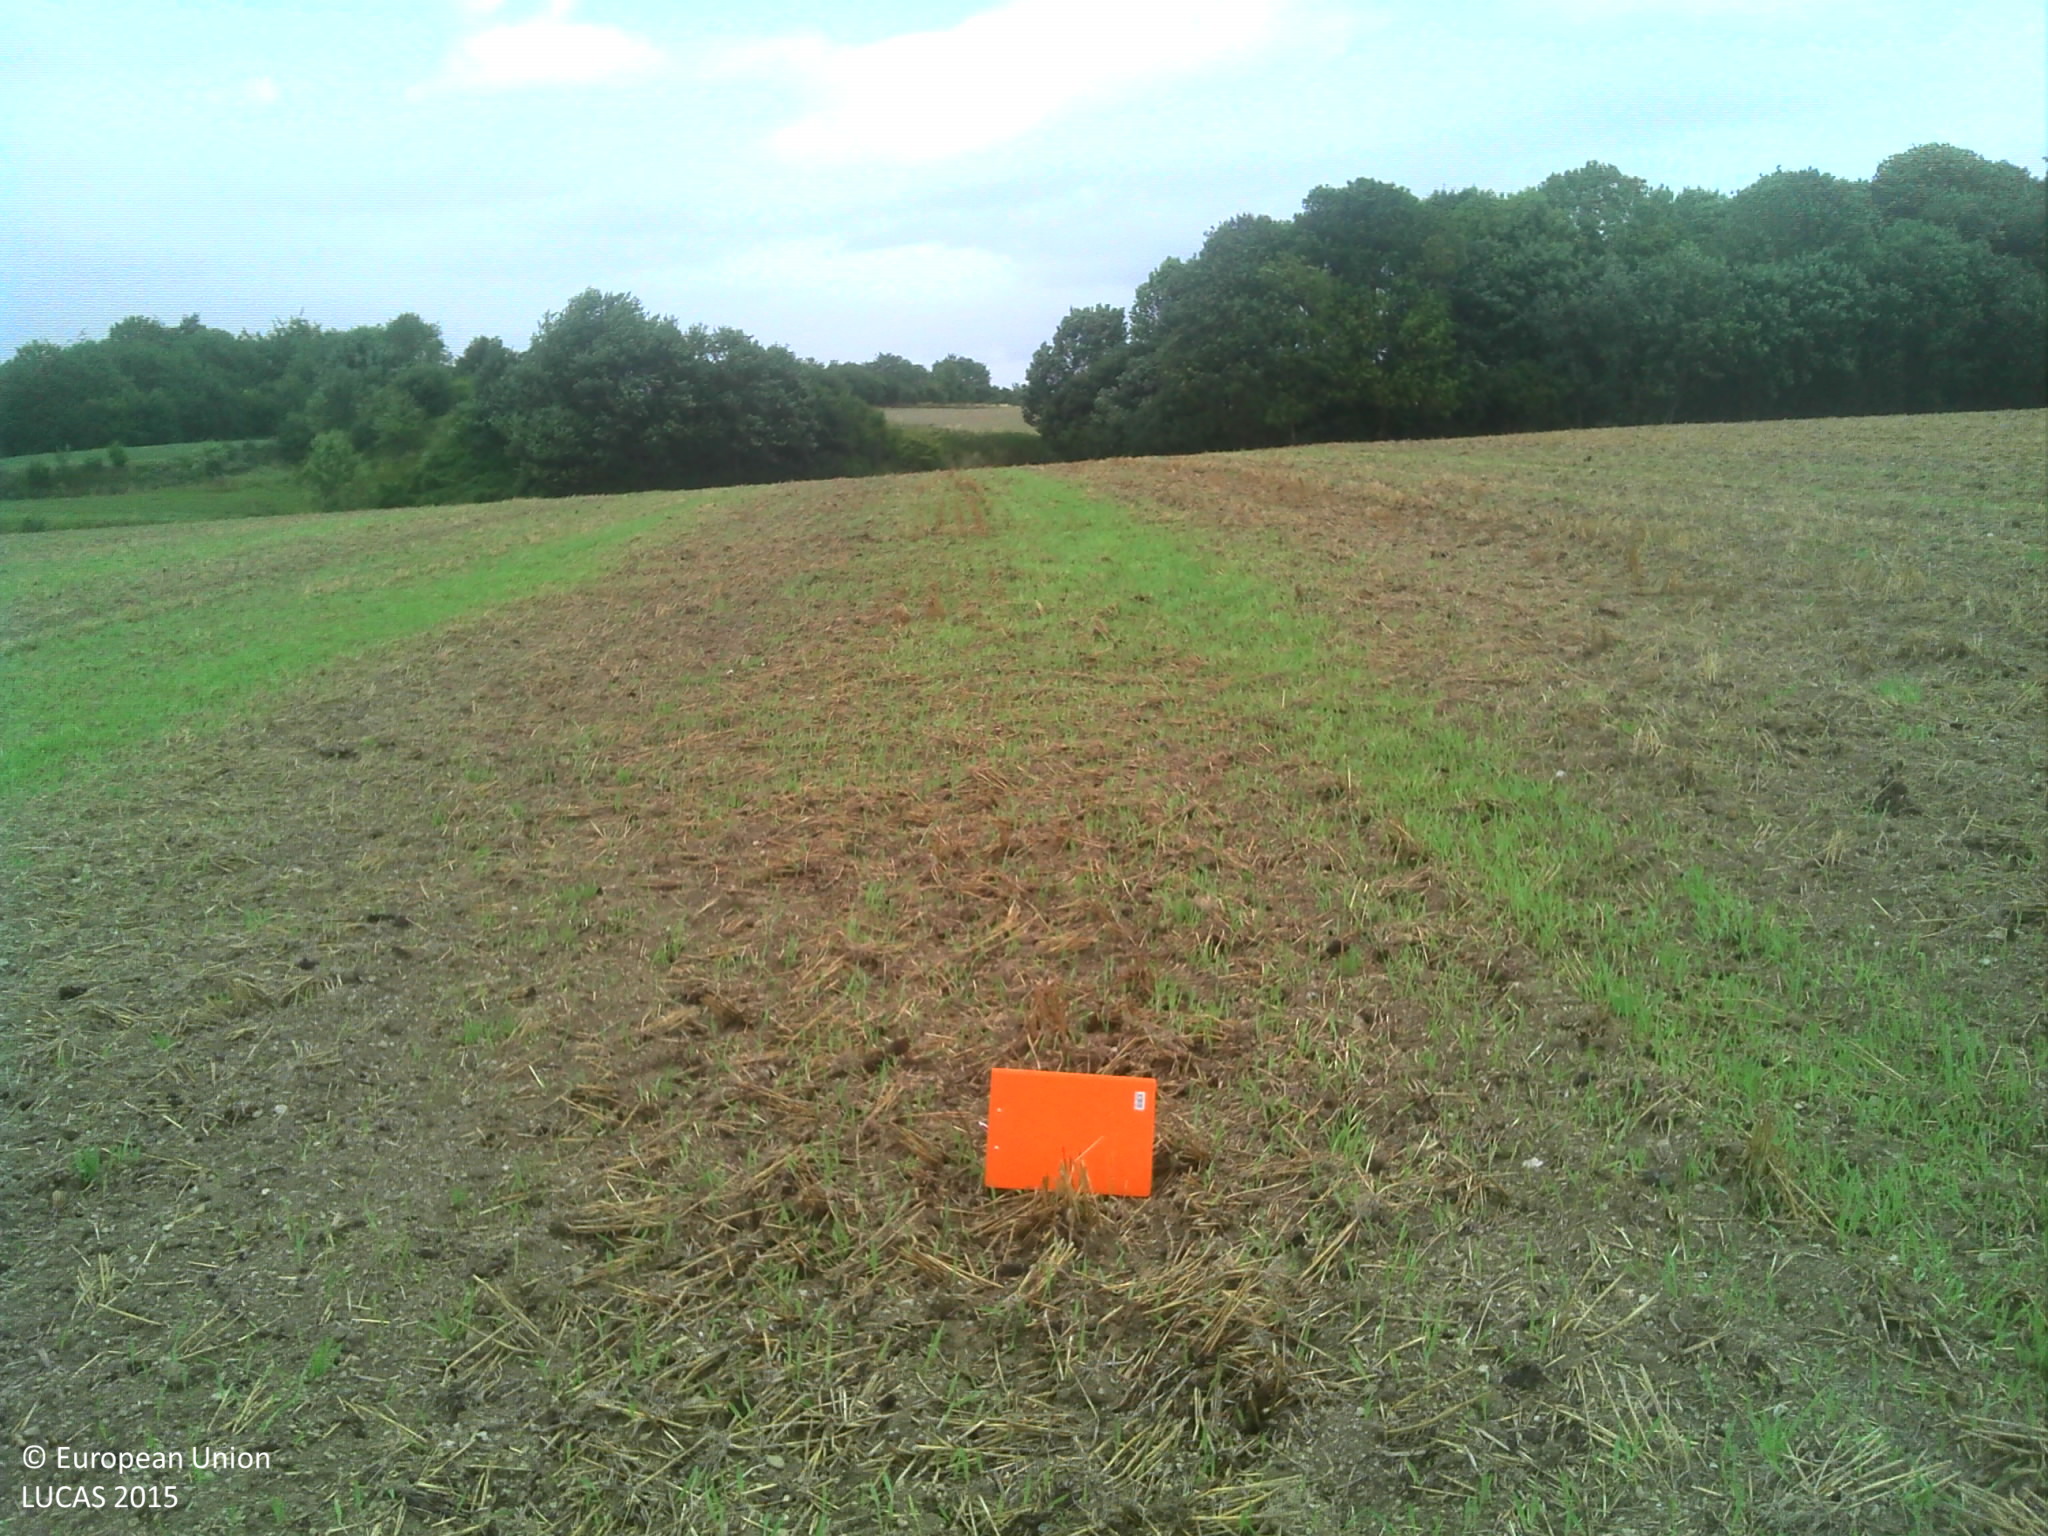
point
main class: Cropland
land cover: Barley
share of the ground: 25 - 50 %
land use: Agriculture (excluding fallow land and kitchen gardens)
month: July
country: FR
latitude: 49.9127
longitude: 3.5730
